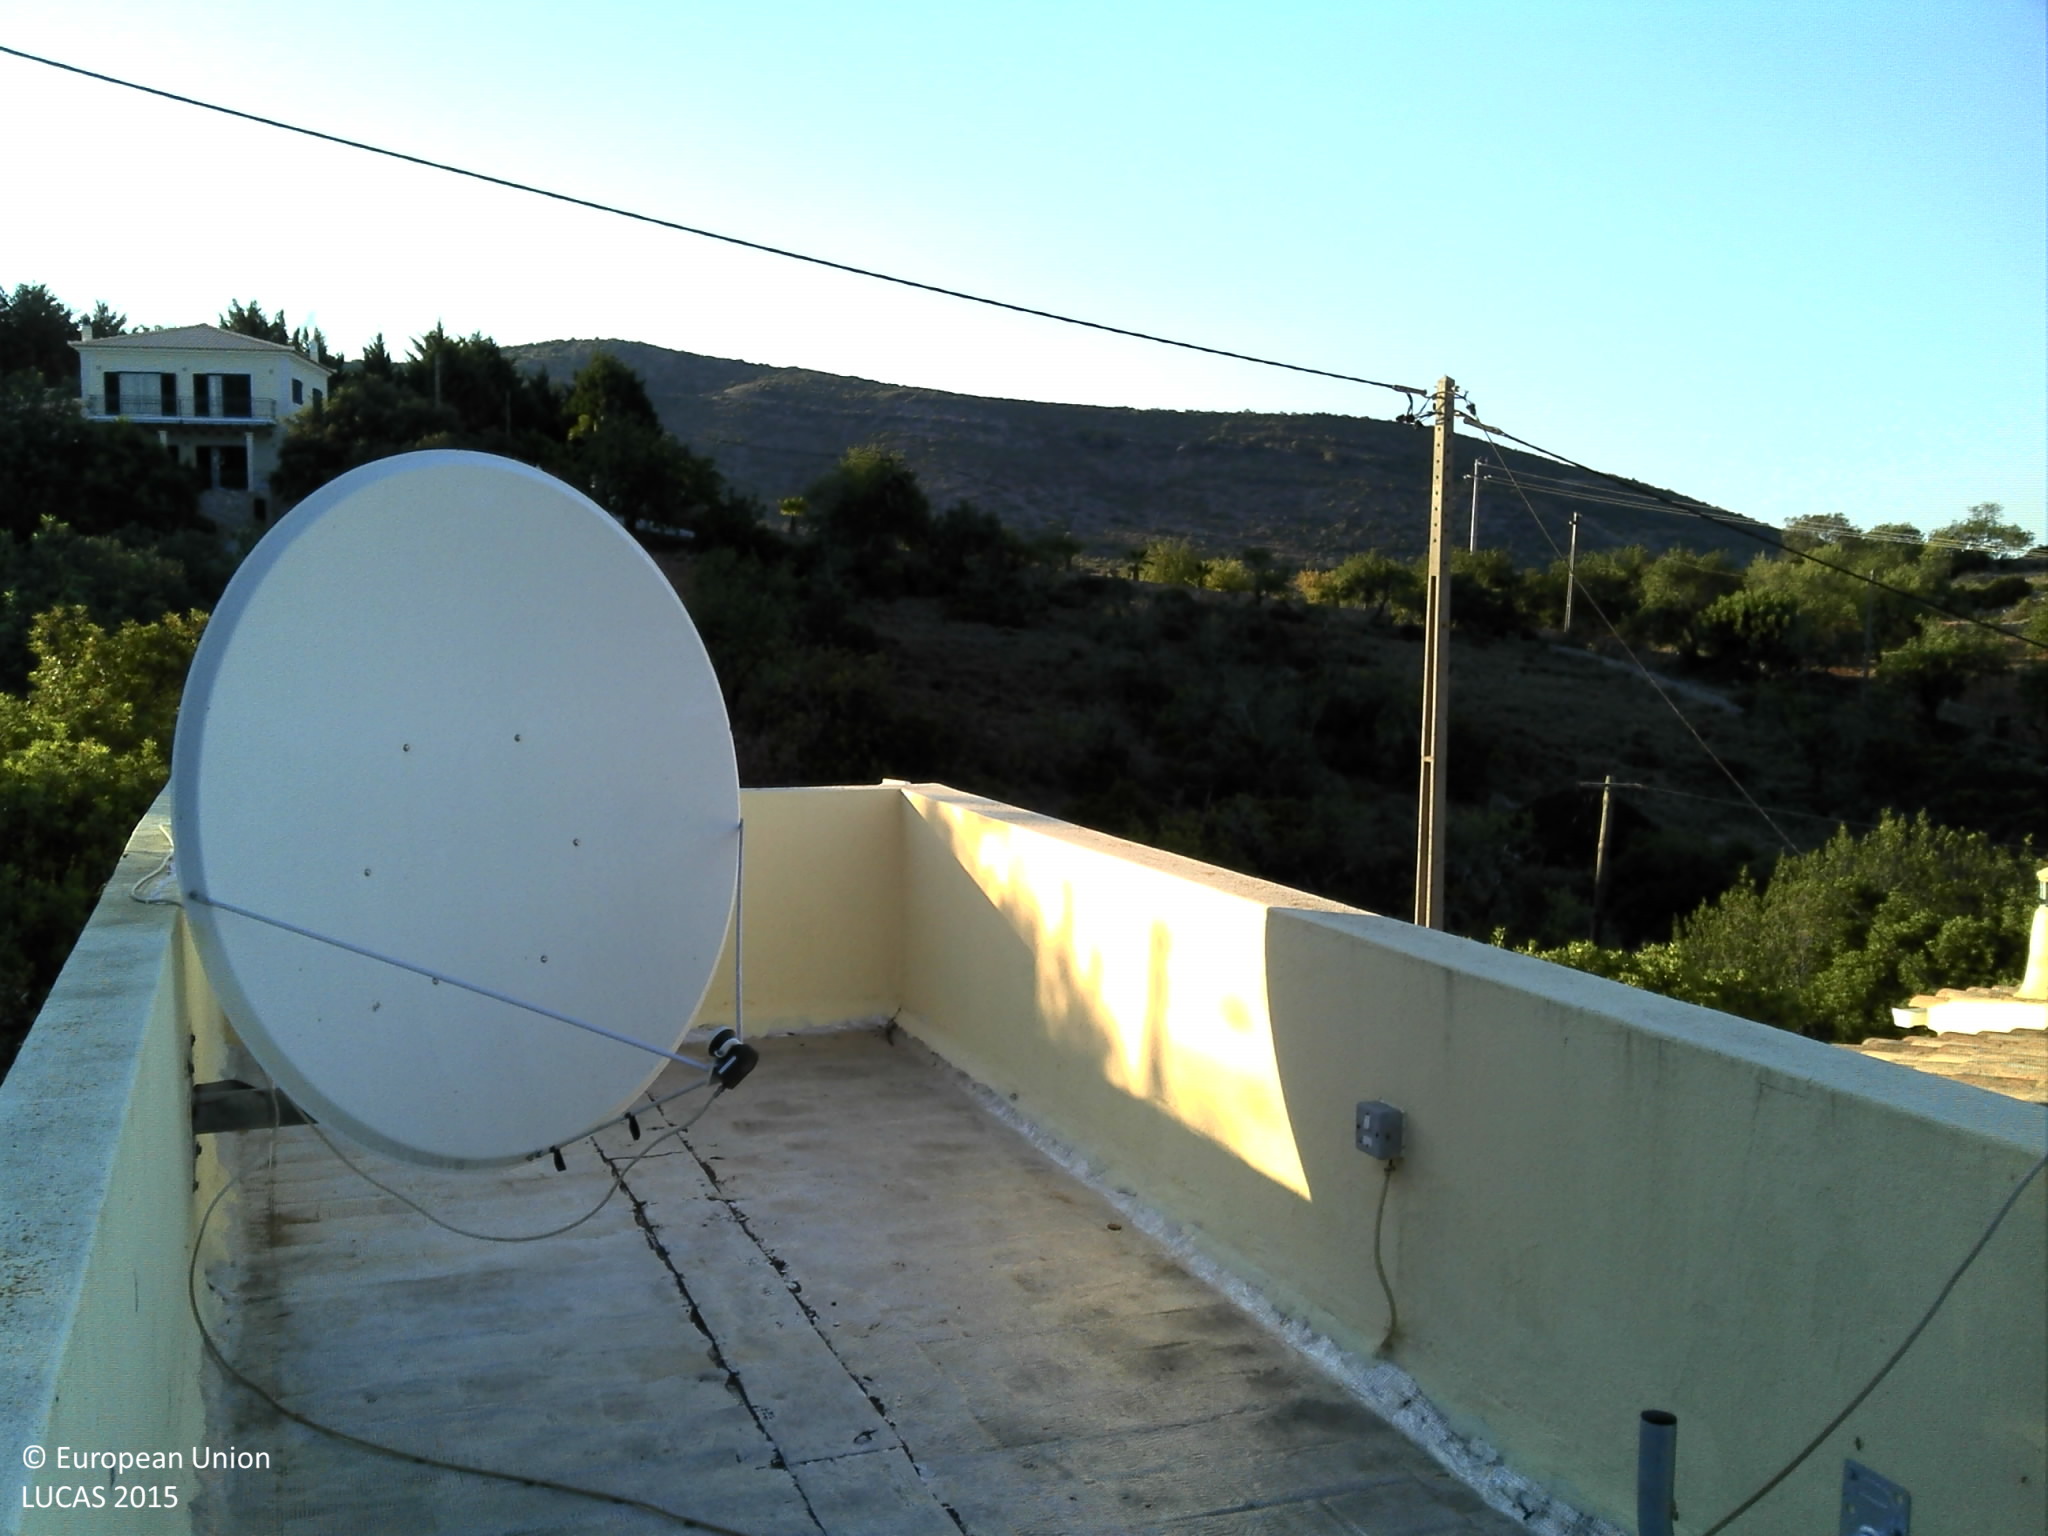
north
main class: Woodland
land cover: Broadleaved woodland
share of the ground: 25 - 50 %
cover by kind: broadleaved forest trees 40 %, unconsolidated bare surface 40 %, herbaceous plants 20 %
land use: Residential
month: June
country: PT
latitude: 37.0870
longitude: -7.8160
